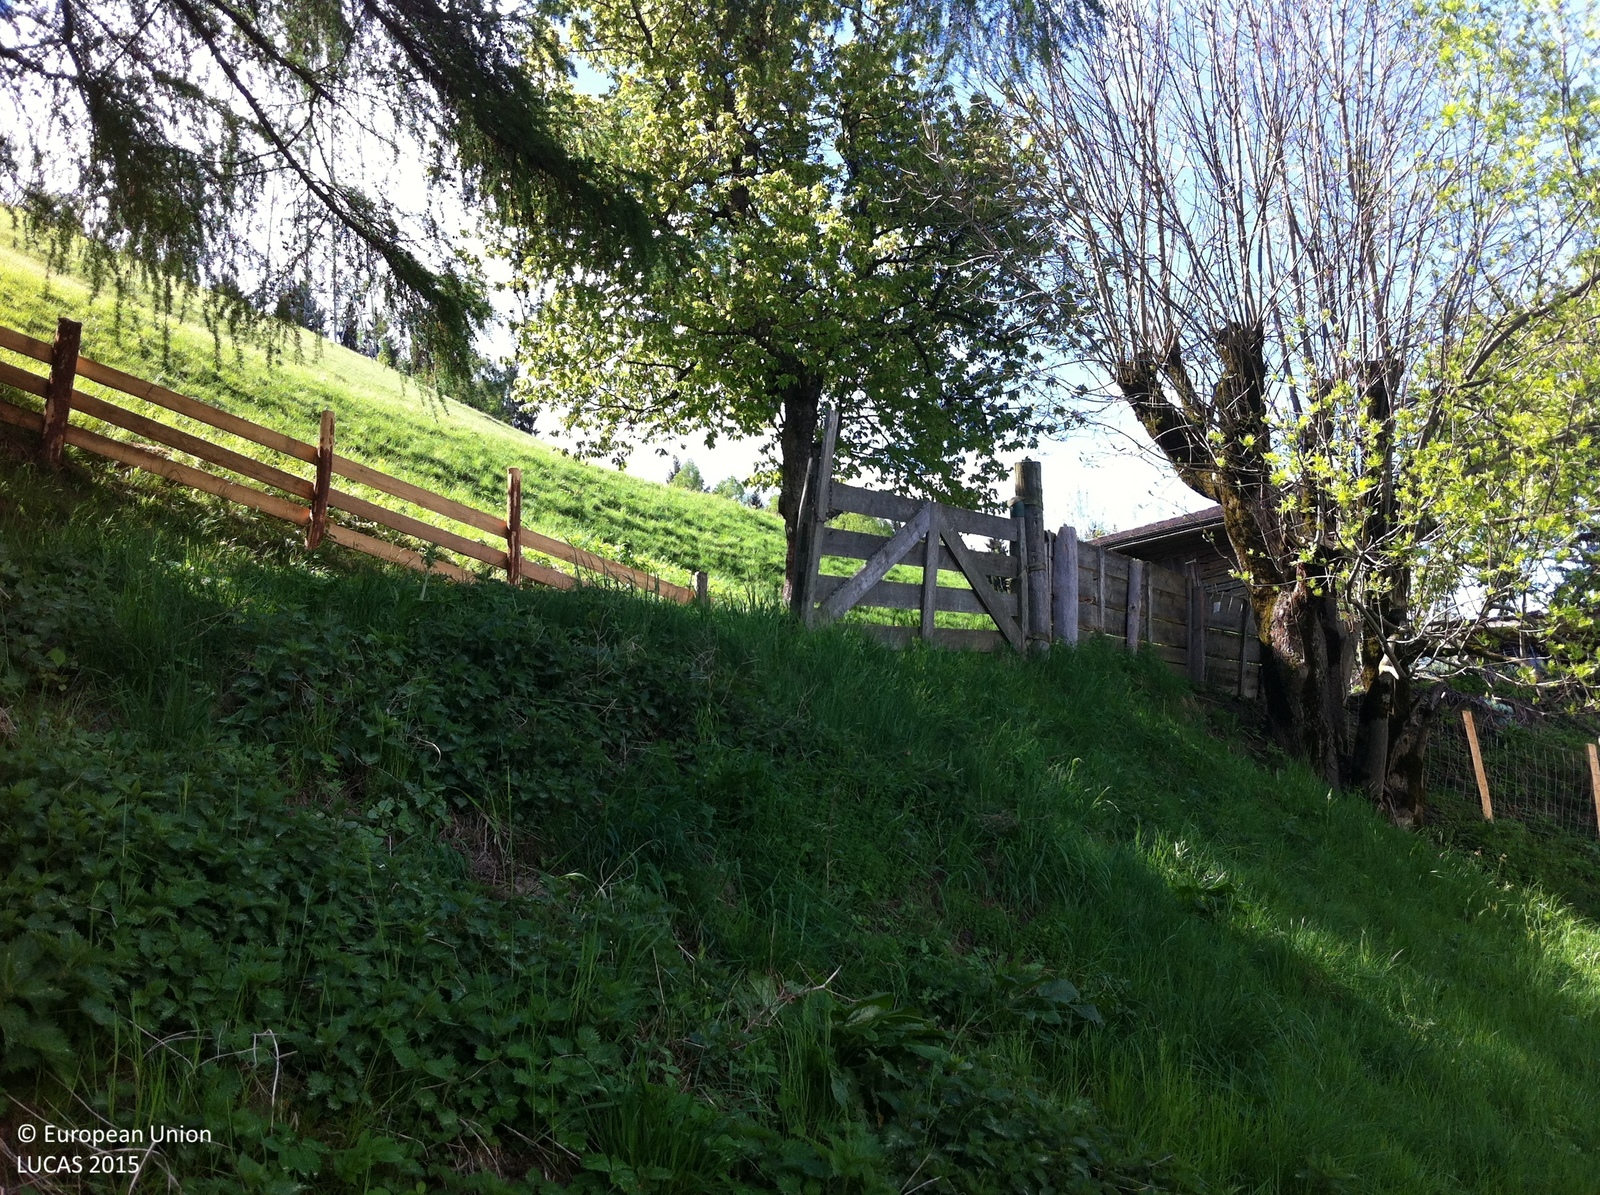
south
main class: Grassland
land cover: Grassland without tree/shrub cover
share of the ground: > 75 %
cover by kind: herbaceous plants 100 %
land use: Agriculture (excluding fallow land and kitchen gardens)
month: May
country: AT
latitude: 47.3458
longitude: 11.7325
